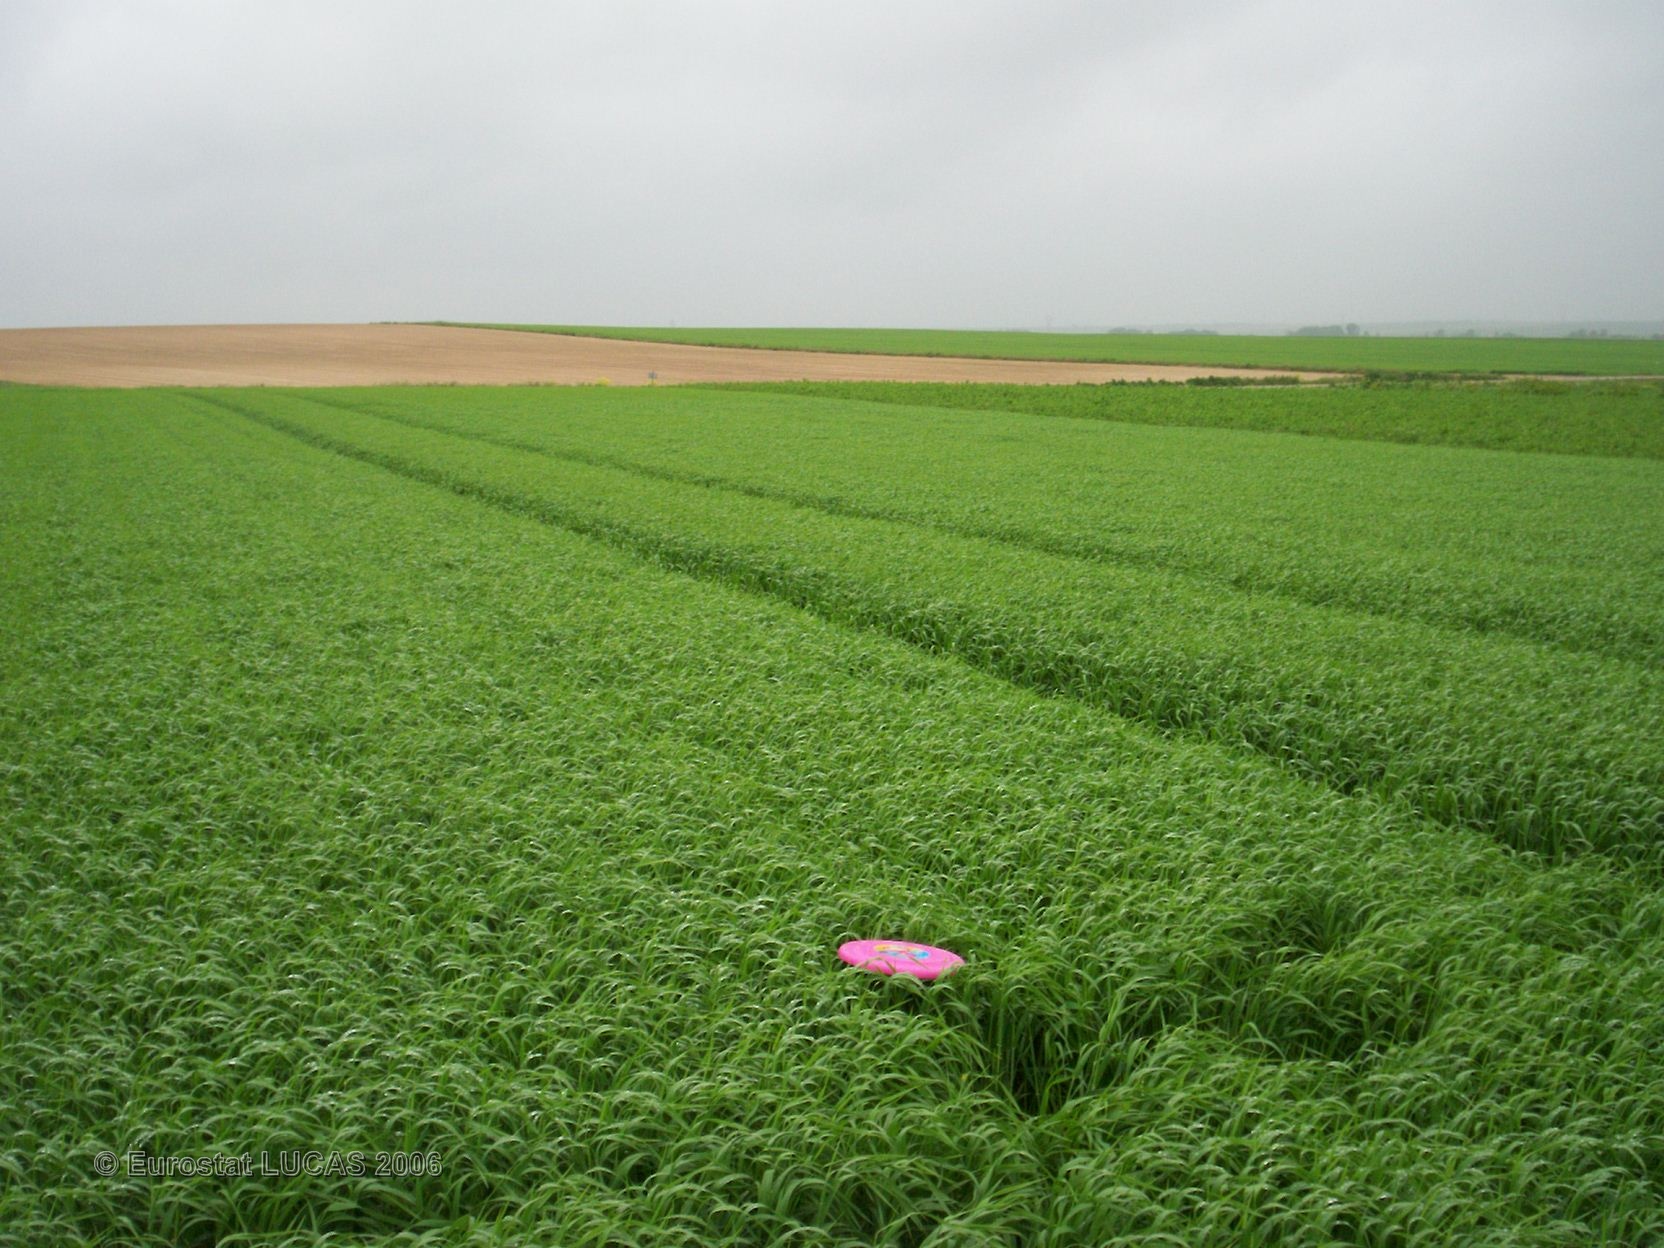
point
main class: Cropland
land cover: Barley
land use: Agriculture (excluding fallow land and kitchen gardens)
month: May
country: FR
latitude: 49.3819
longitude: 4.4450
